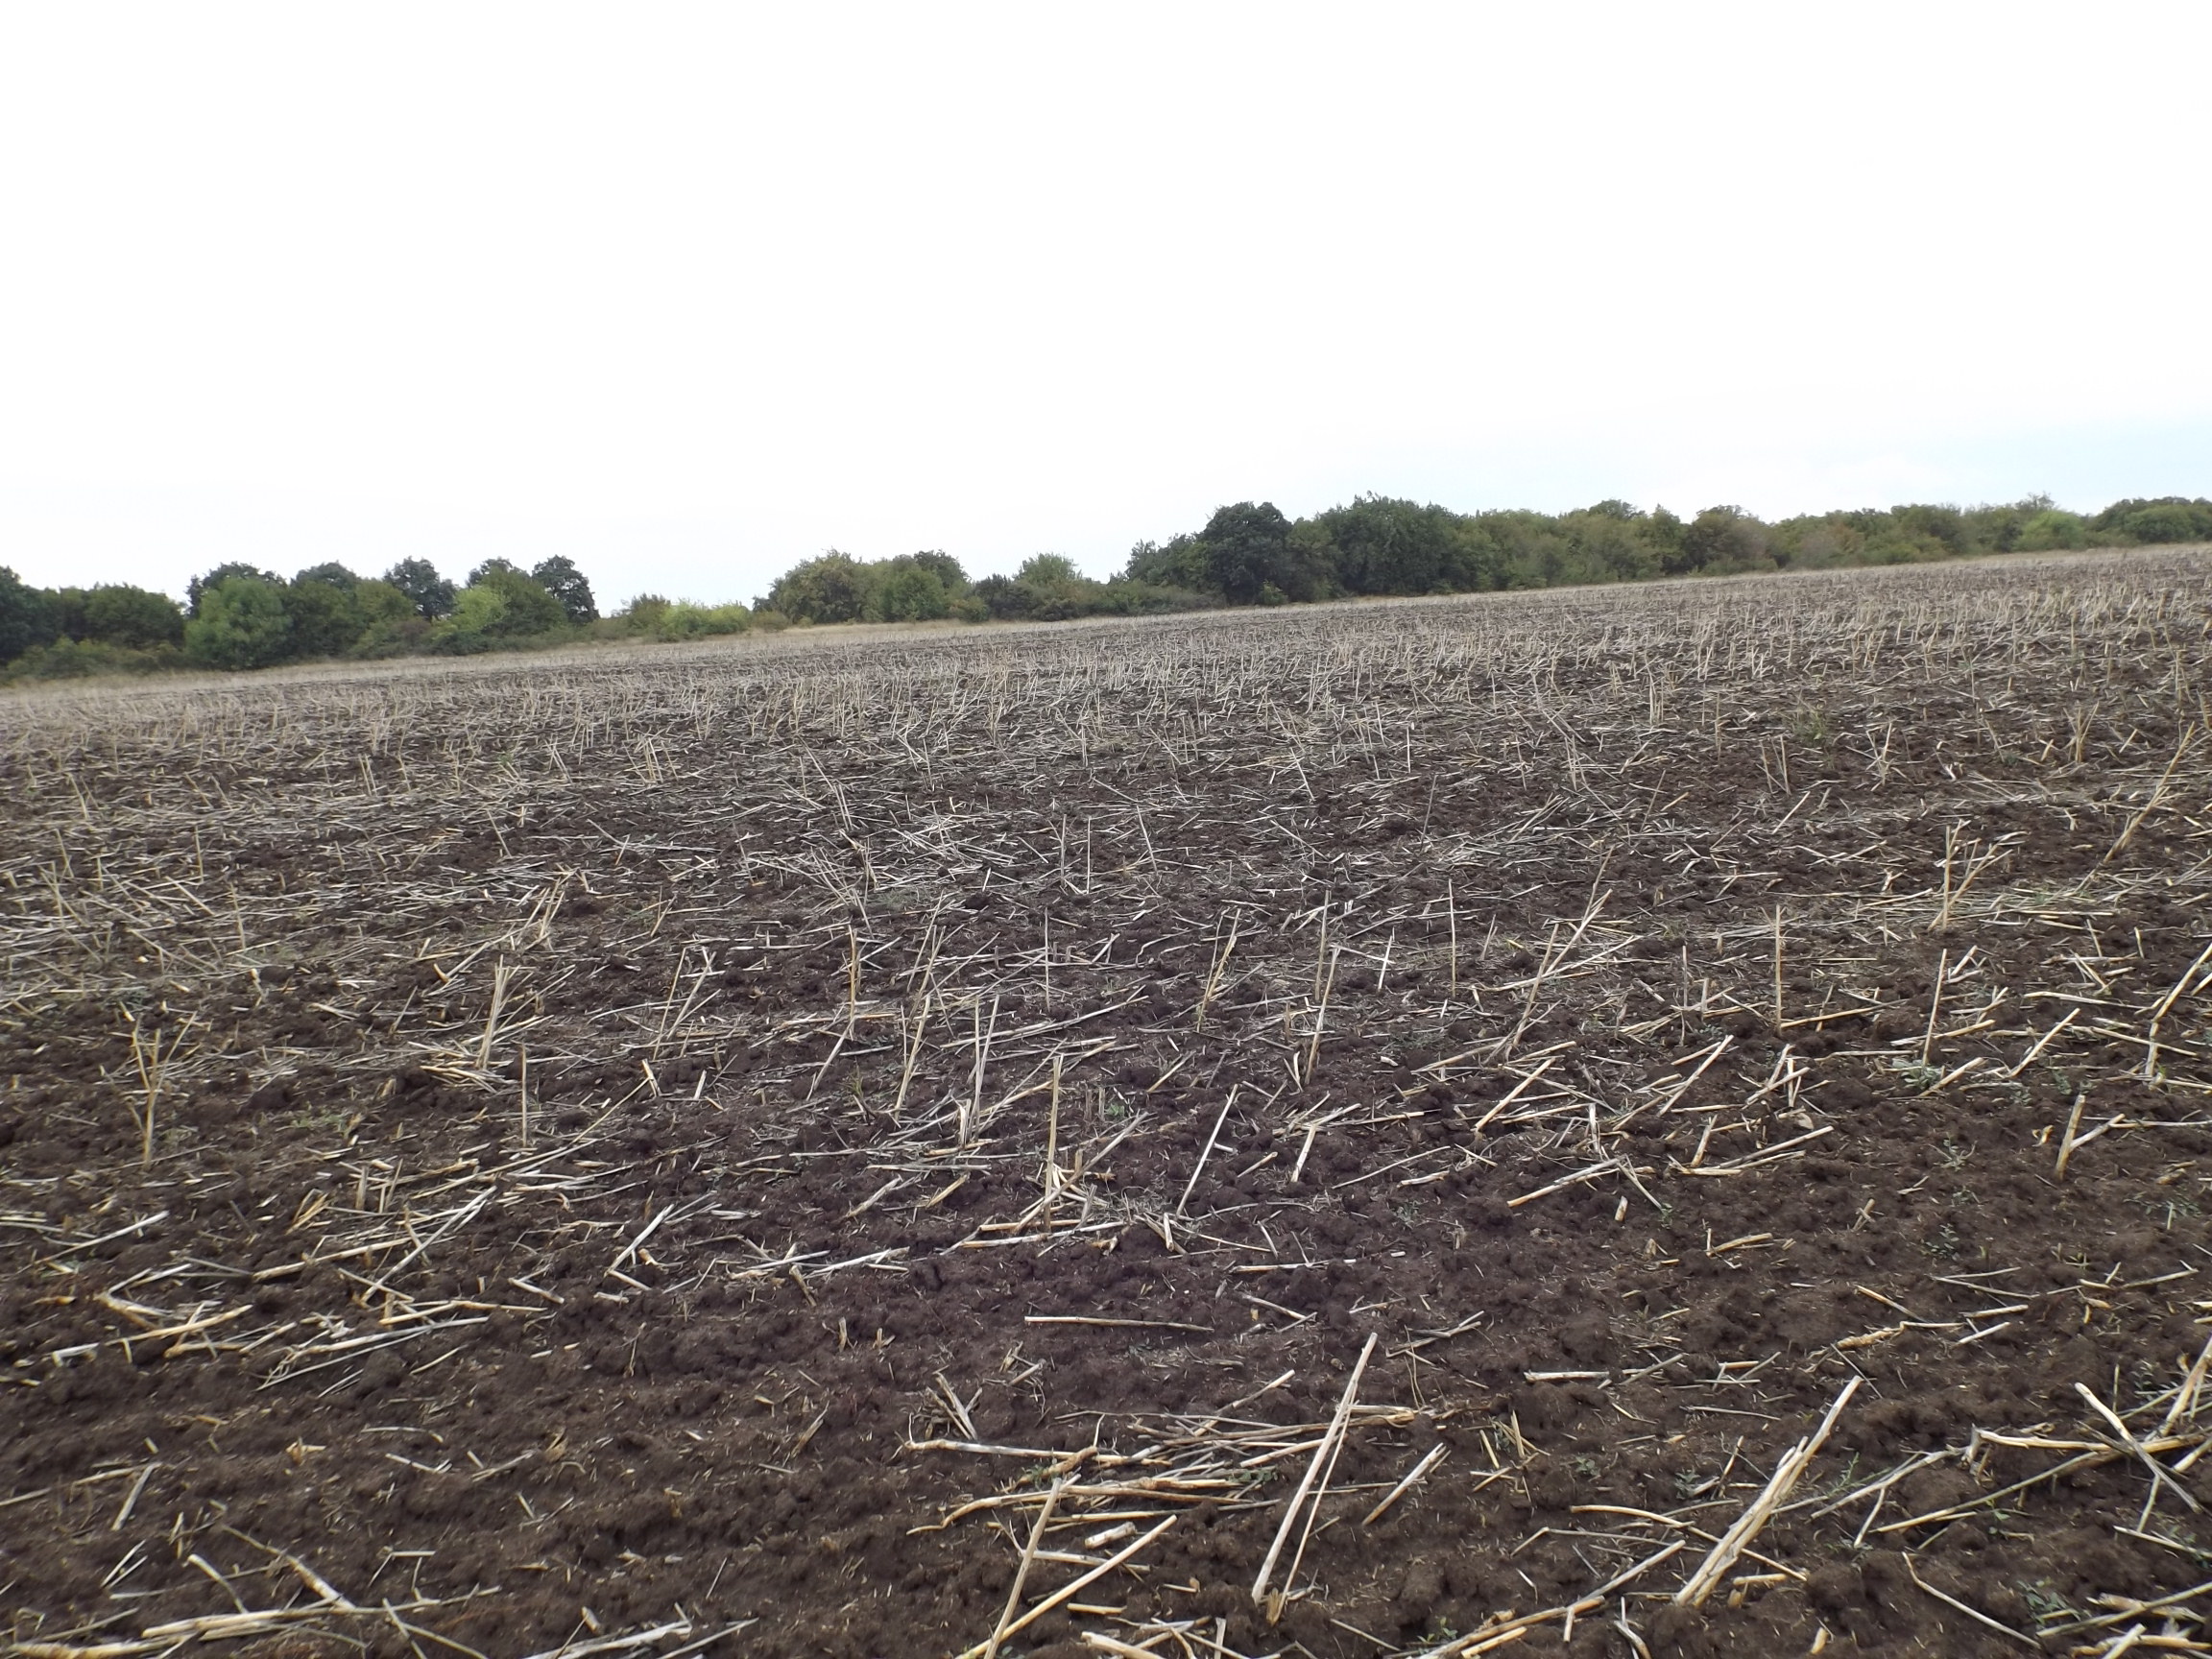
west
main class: Cropland
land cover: Maize
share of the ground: < 10 %
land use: Agriculture (excluding fallow land and kitchen gardens)
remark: Harvested field
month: August
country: BG
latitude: 43.1923
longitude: 27.5400
